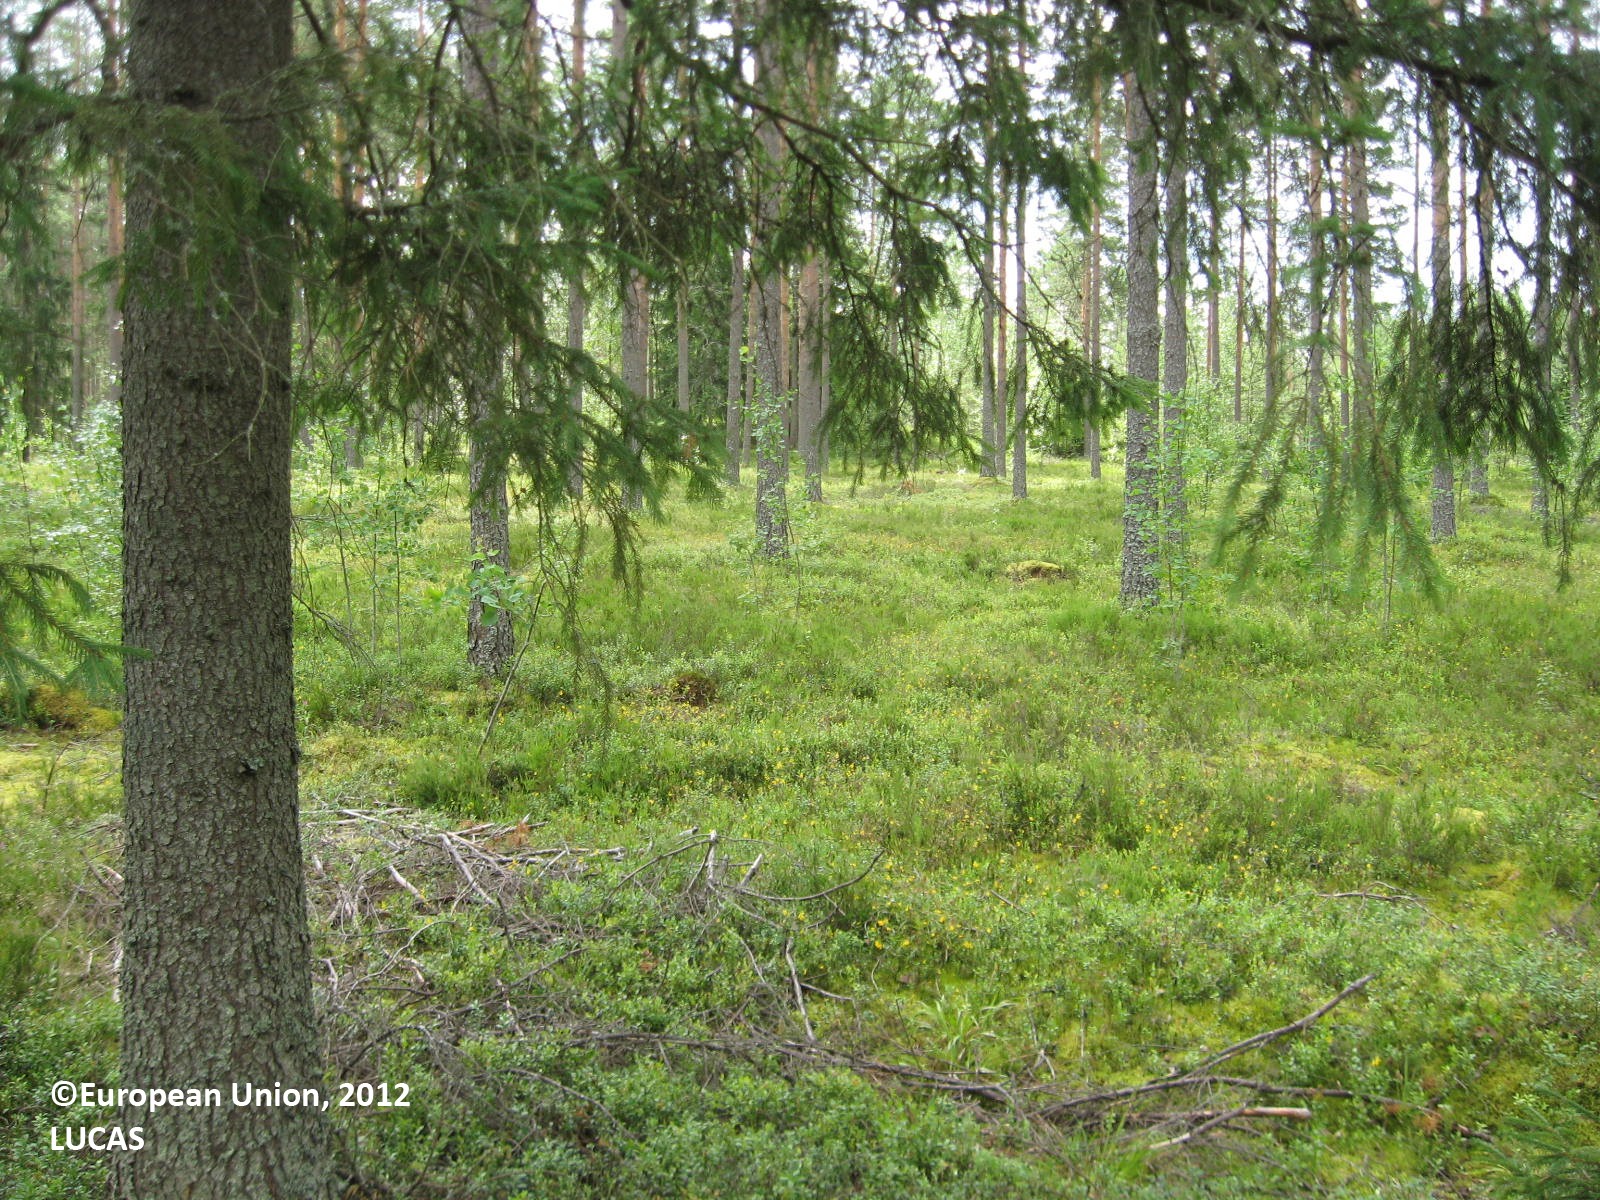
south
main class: Woodland
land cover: Pine dominated coniferous woodland
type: boreal forest
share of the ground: > 75 %
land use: Forestry
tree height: > 5 m
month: July
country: FI
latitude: 62.1444
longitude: 22.2761
